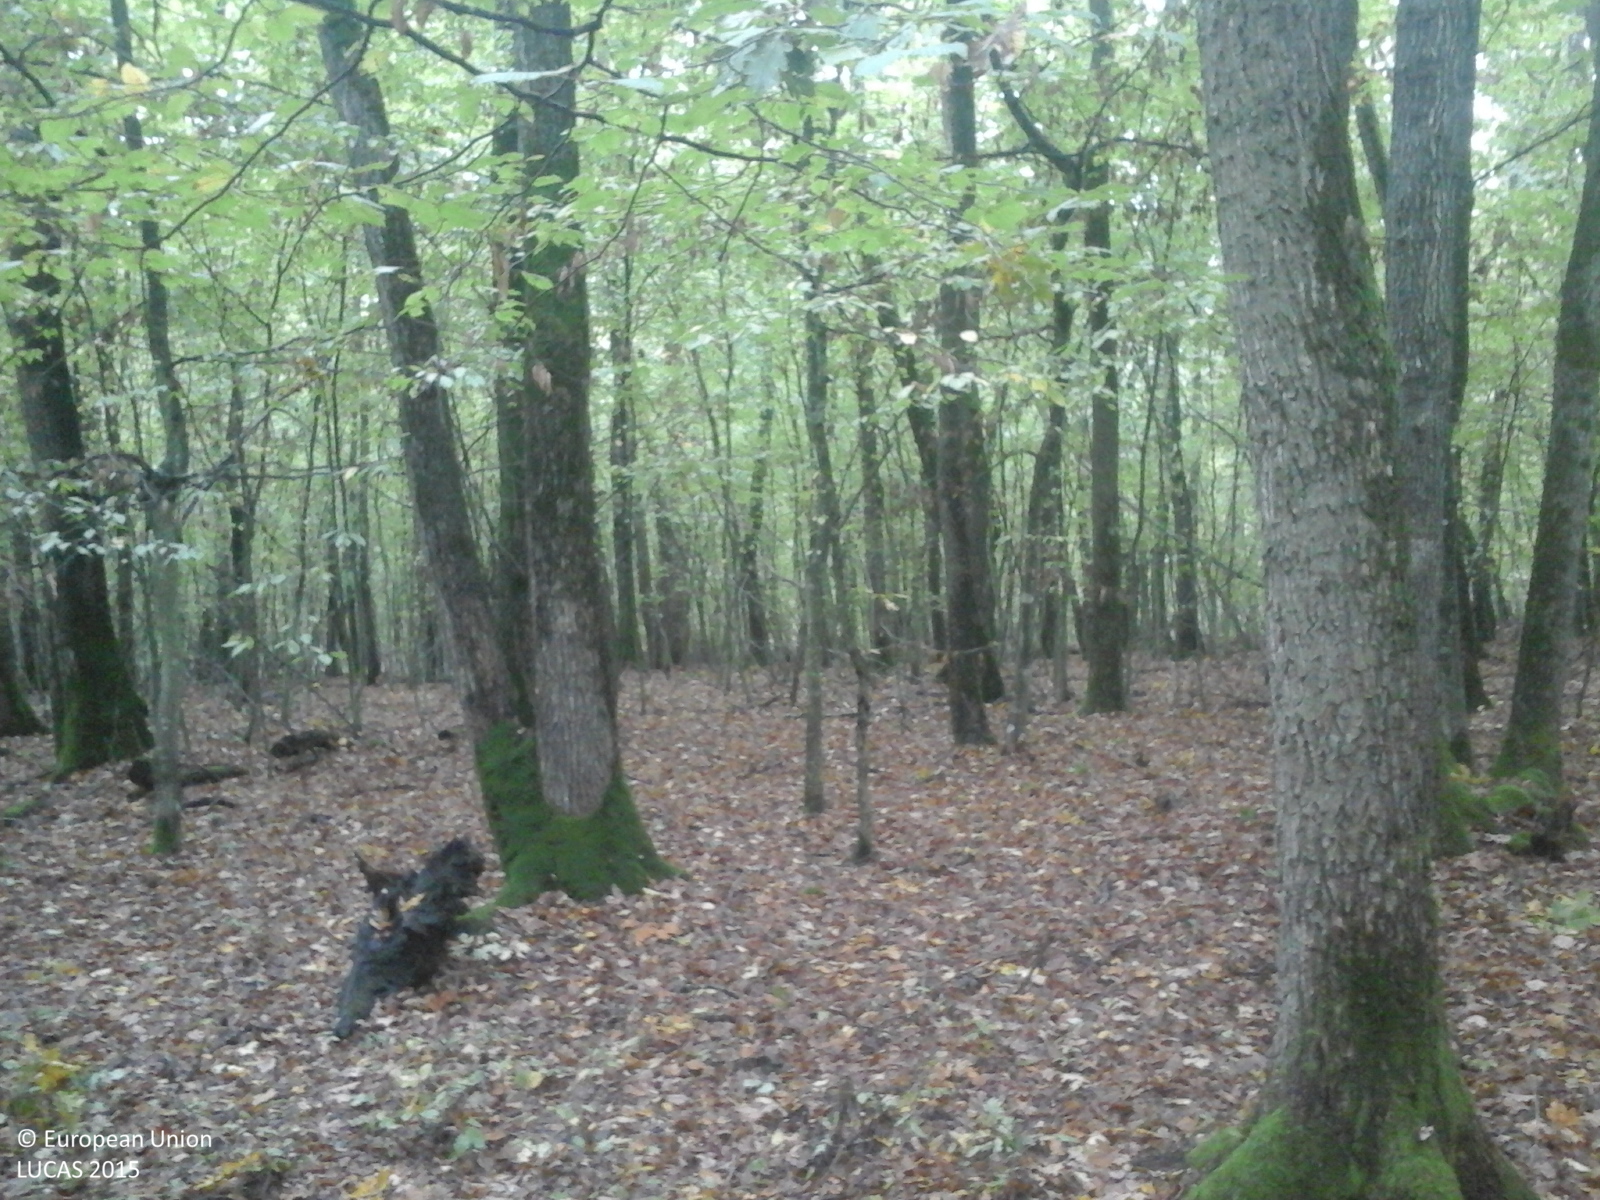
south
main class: Woodland
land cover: Broadleaved woodland
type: acidophilous oak and oak-birch forest
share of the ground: > 75 %
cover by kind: broadleaved forest trees 100 %
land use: Forestry
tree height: > 5 m
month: October
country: RO
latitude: 45.8620
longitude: 24.8110
